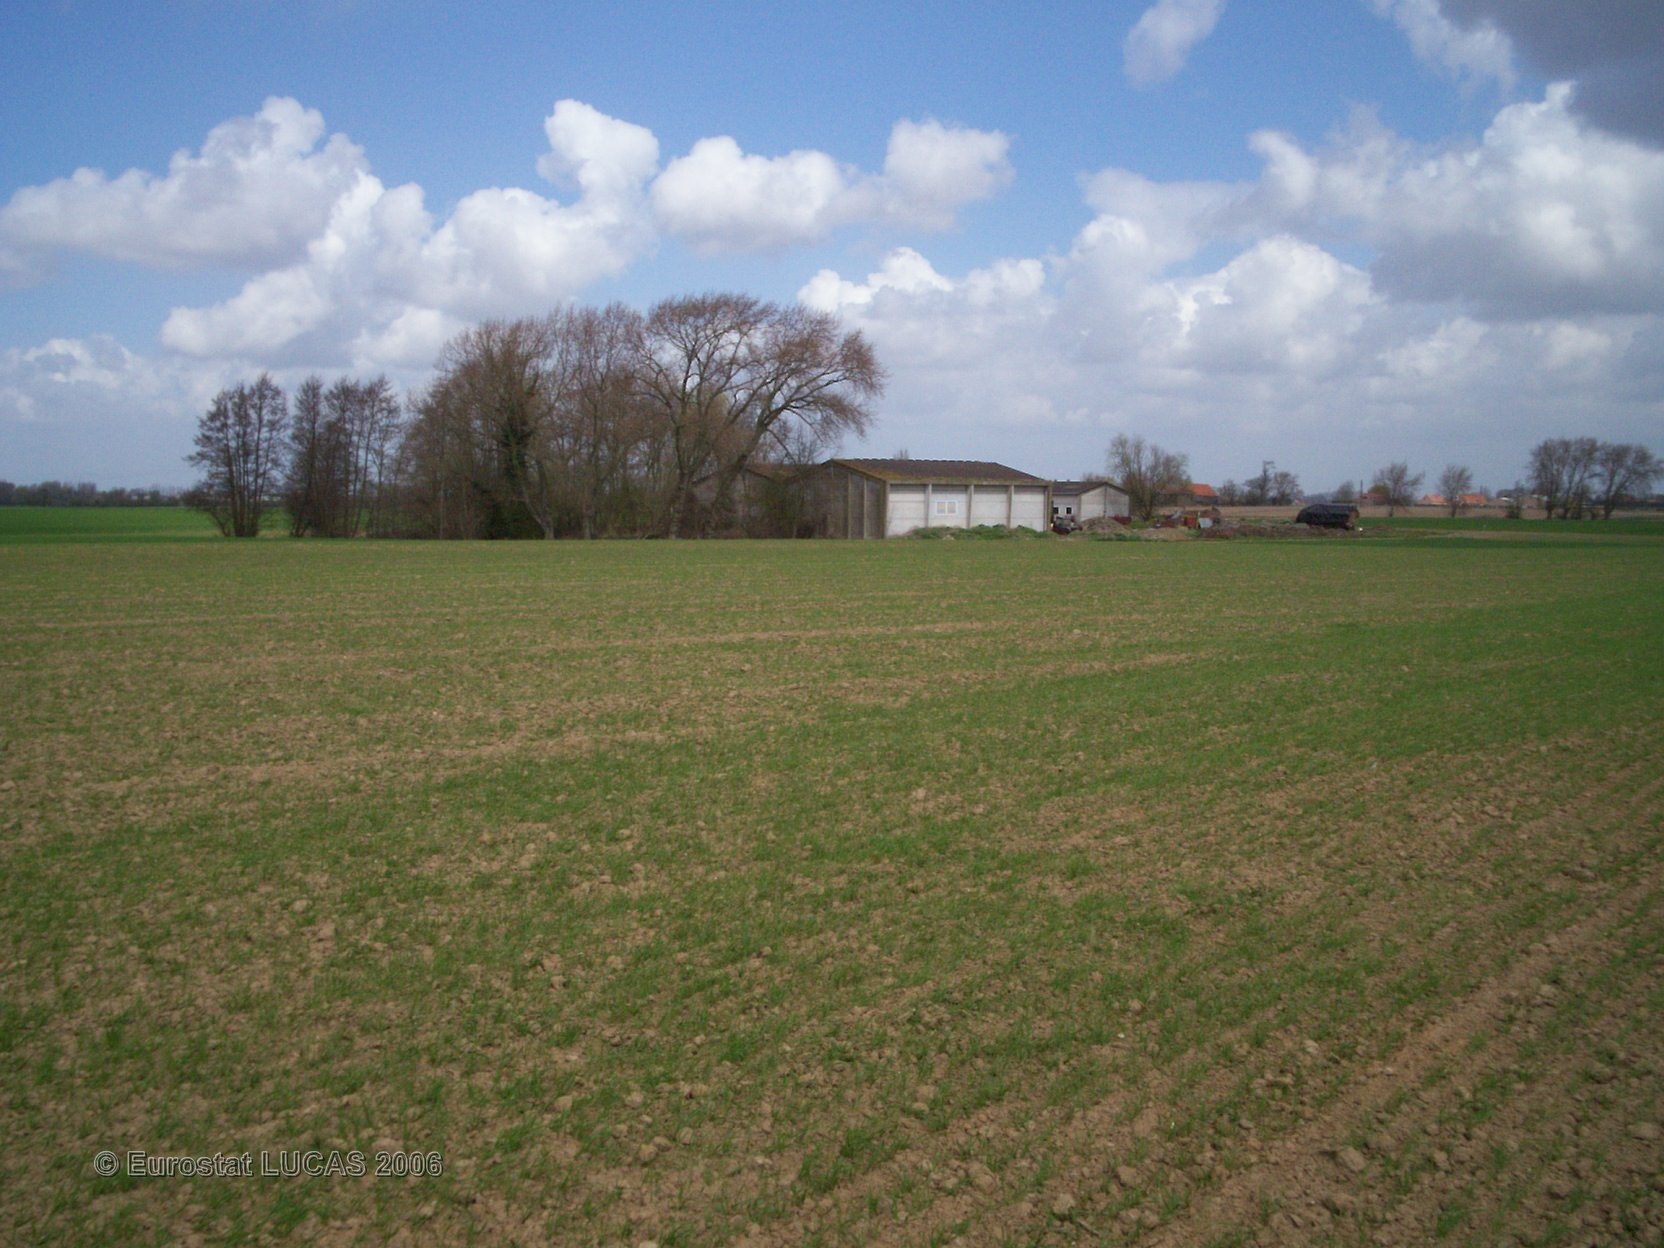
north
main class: Cropland
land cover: Common wheat
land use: Agriculture (excluding fallow land and kitchen gardens)
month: April
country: FR
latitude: 50.8581
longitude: 2.5005
